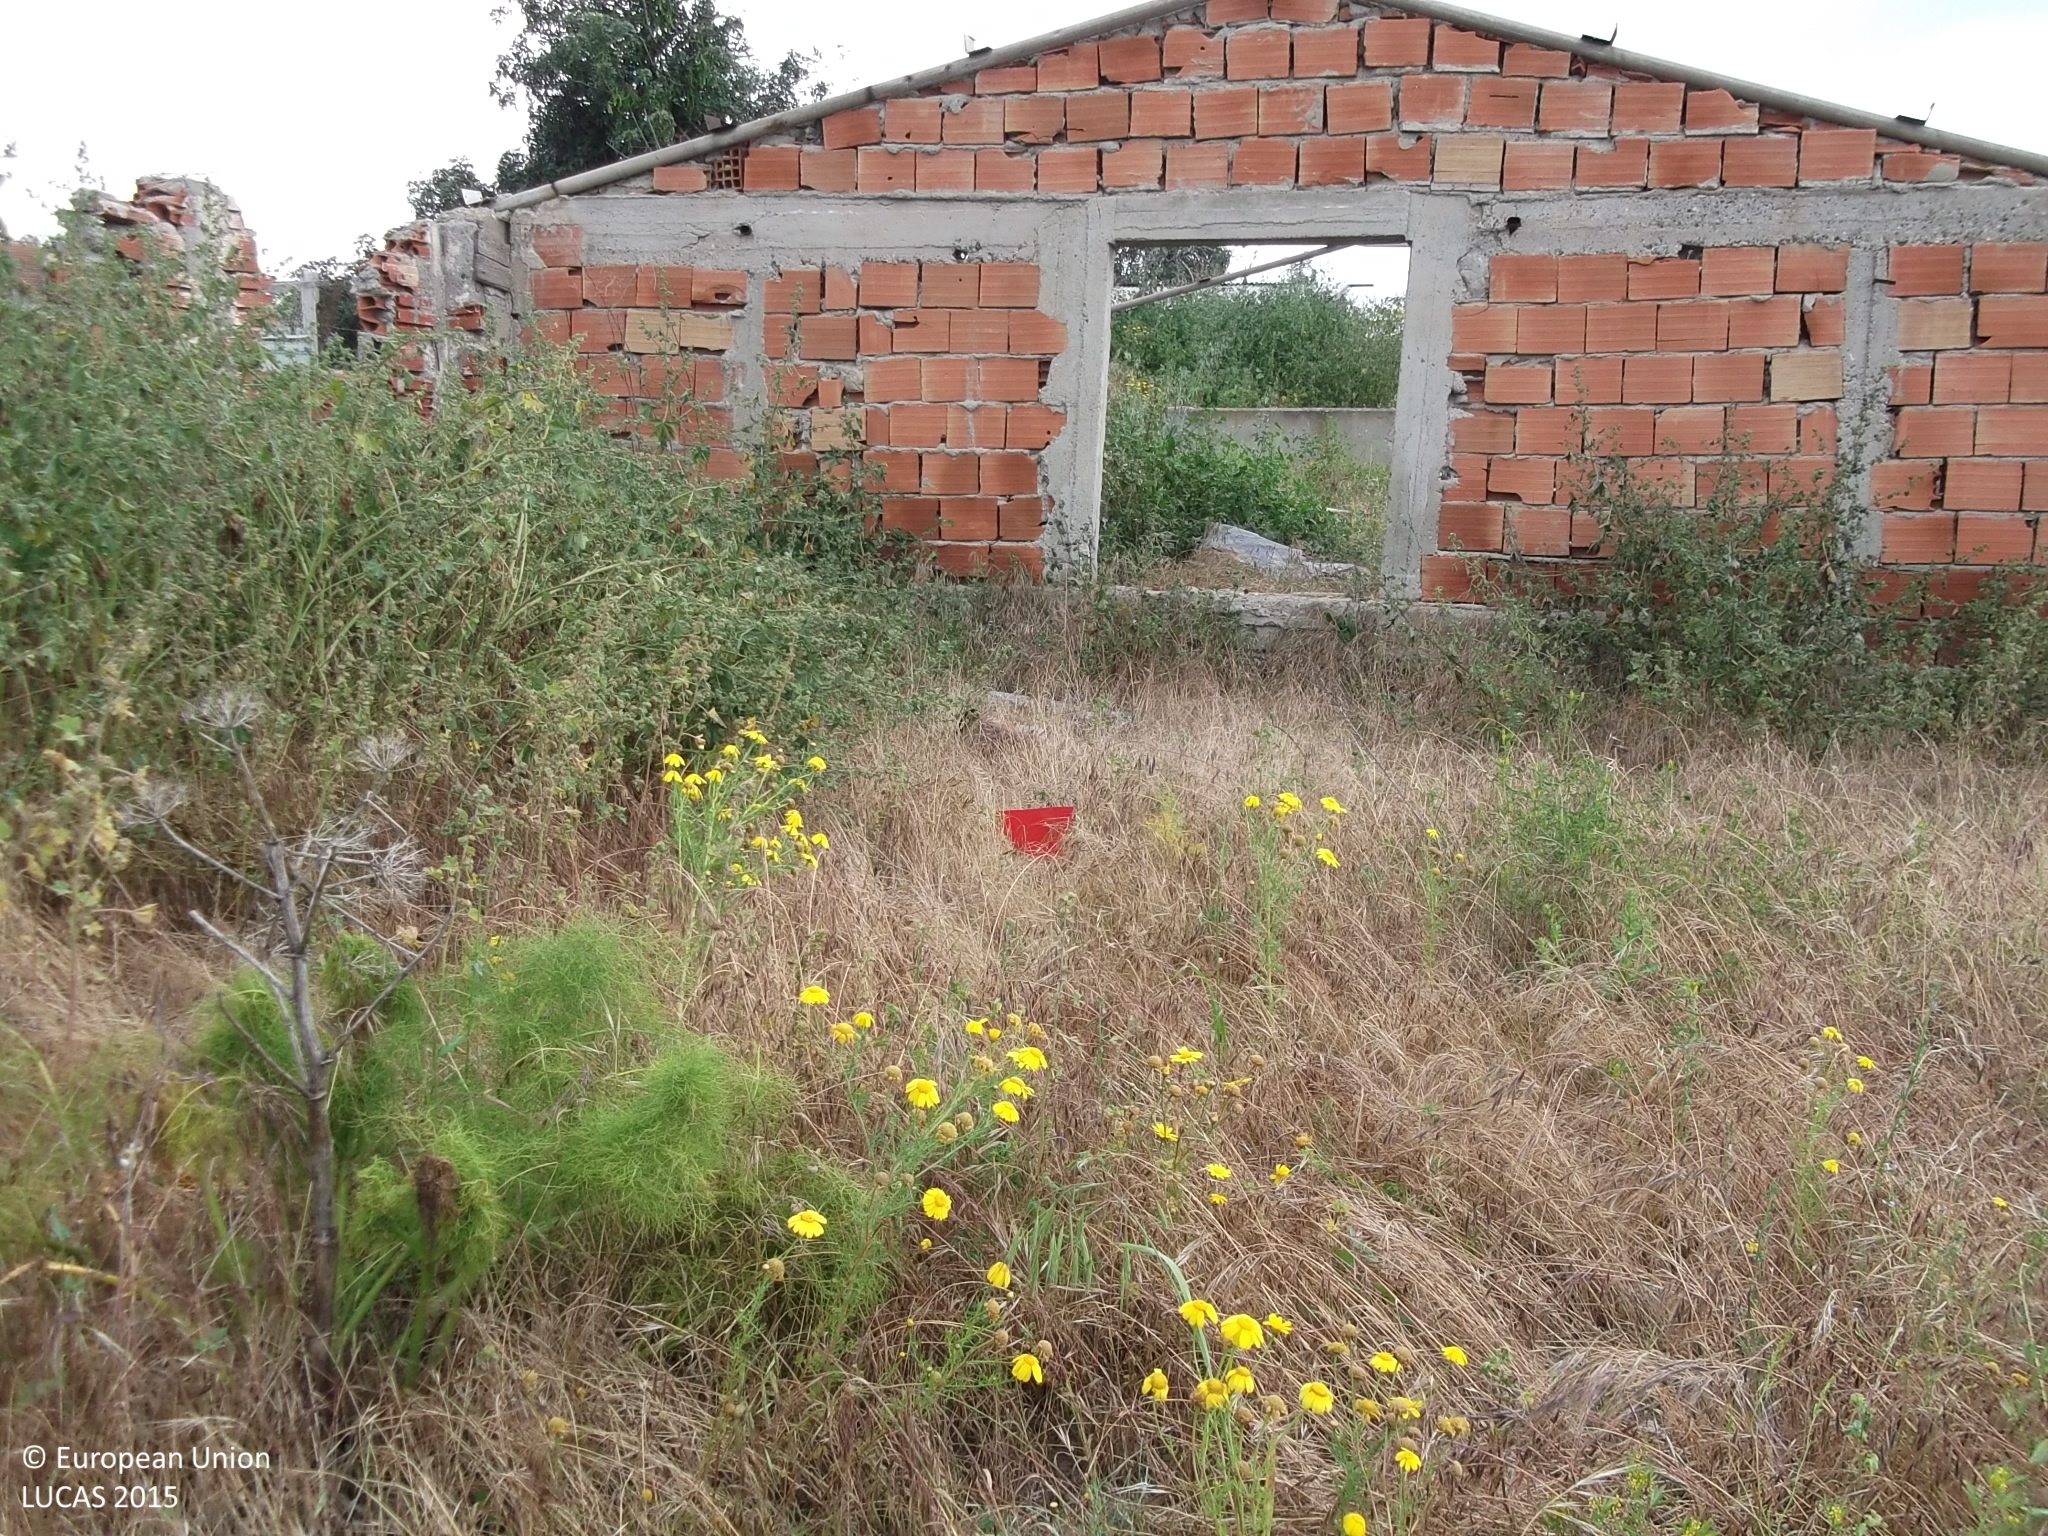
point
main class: Grassland
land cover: Grassland without tree/shrub cover
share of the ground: > 75 %
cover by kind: herbaceous plants 100 %
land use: Abandoned areas
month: April
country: CY
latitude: 34.7960
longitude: 33.5000
